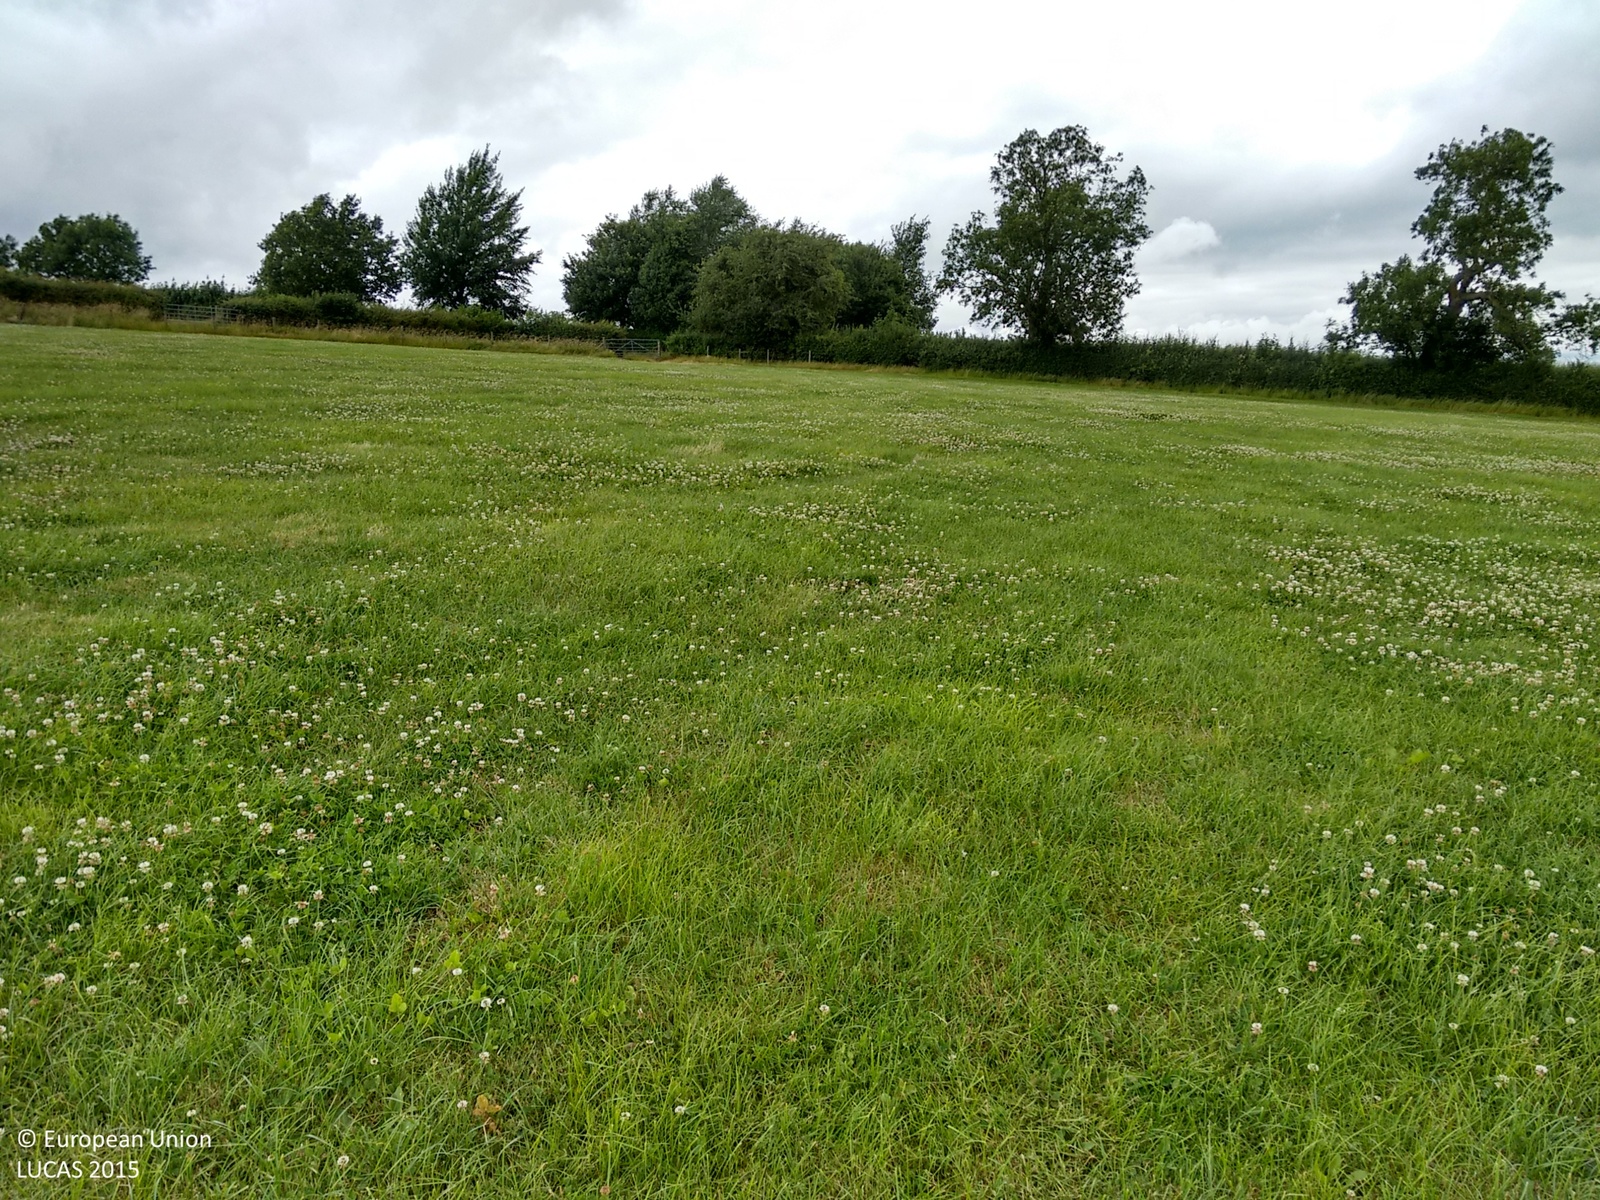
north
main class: Grassland
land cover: Grassland without tree/shrub cover
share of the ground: > 75 %
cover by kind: herbaceous plants 100 %
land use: Agriculture (excluding fallow land and kitchen gardens)
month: July
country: GB
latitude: 52.1227
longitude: -1.3392
